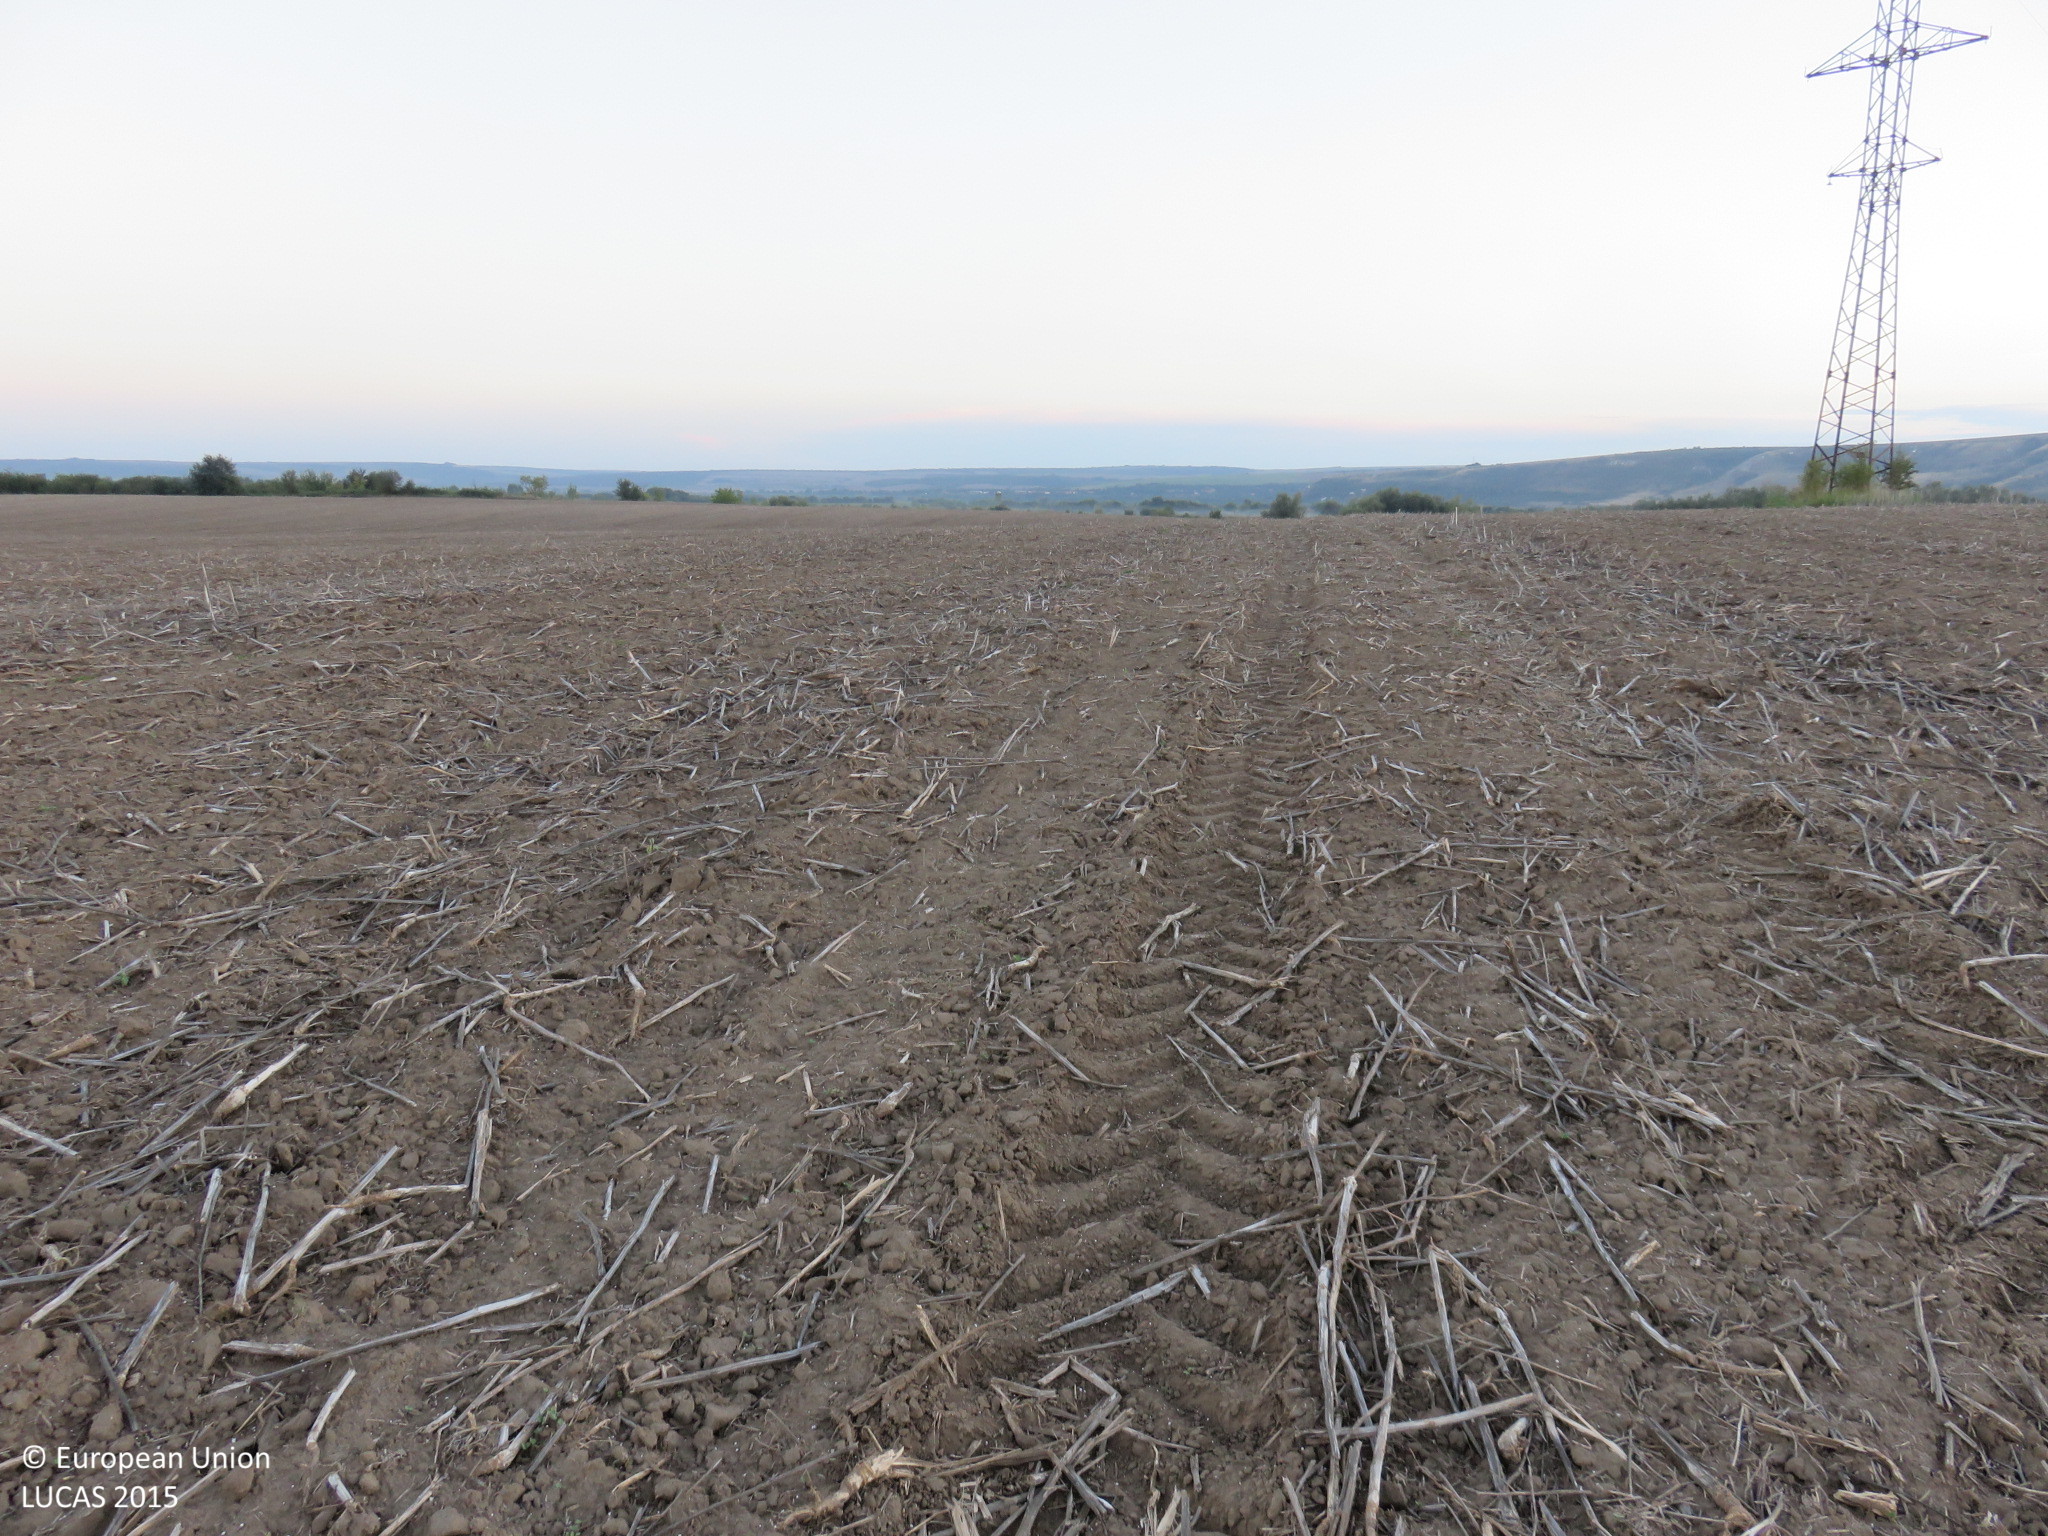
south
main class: Cropland
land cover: Rape and turnip rape
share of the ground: < 10 %
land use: Agriculture (excluding fallow land and kitchen gardens)
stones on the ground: < 10 %
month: September
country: BG
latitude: 43.6679
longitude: 25.0429
